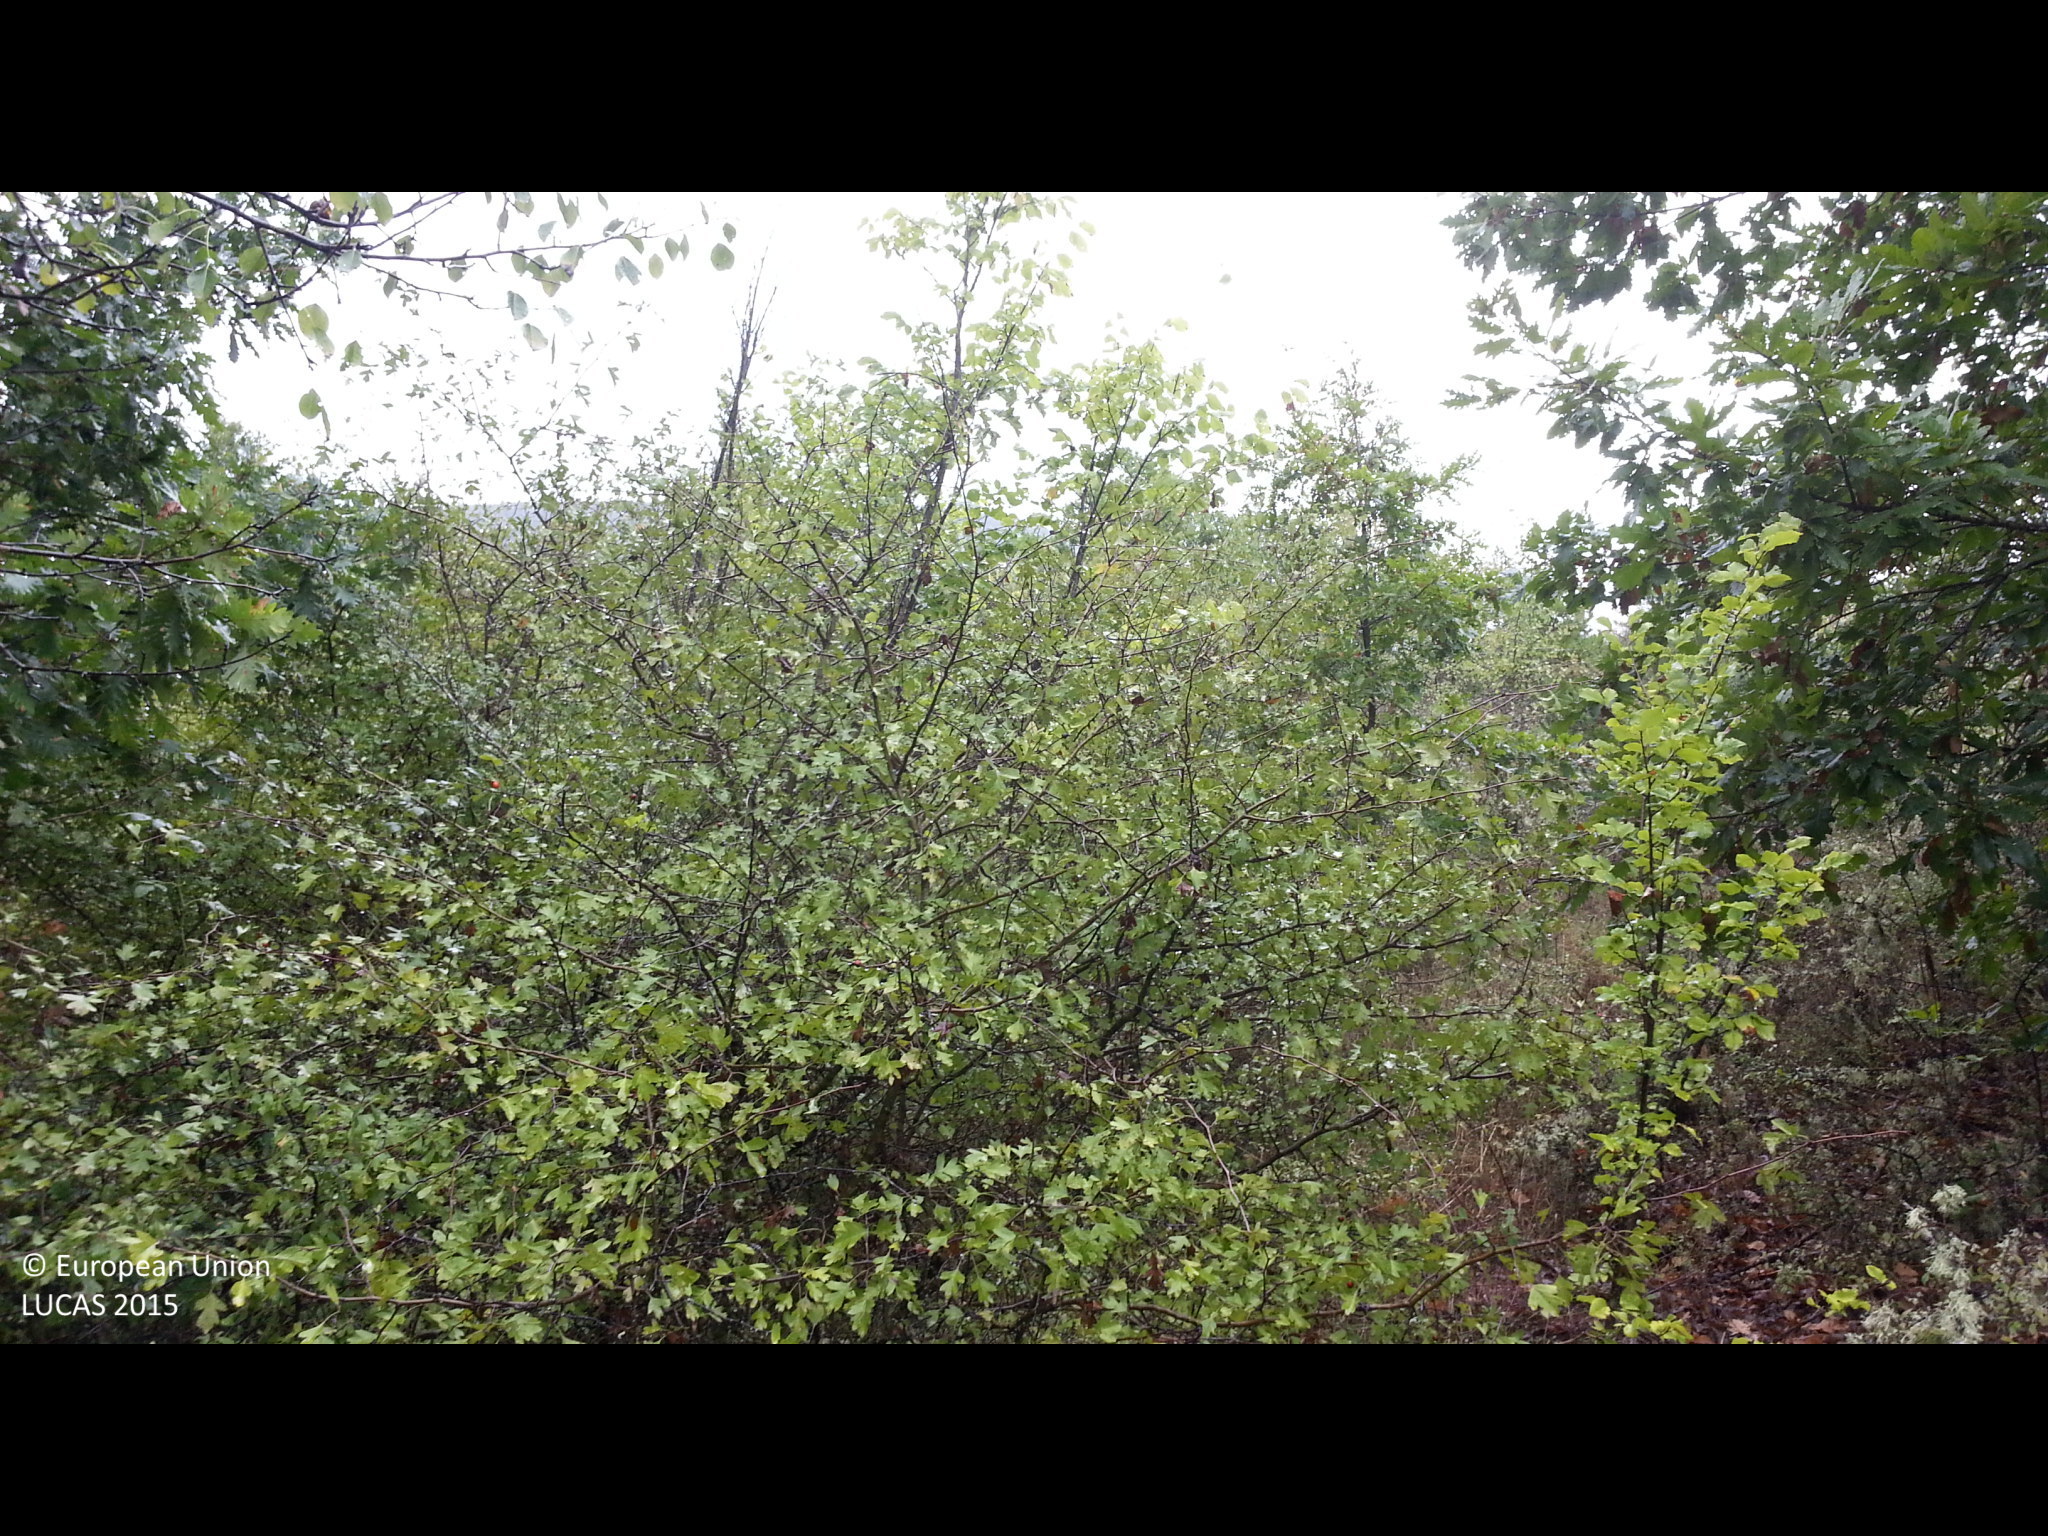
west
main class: Shrubland
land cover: Shrubland with sparse tree cover
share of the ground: > 75 %
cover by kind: shrubs 95 %, broadleaved forest trees 5 %
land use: Semi-natural and natural areas not in use
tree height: < 5 m
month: September
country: BG
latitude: 42.5031
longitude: 22.7412
